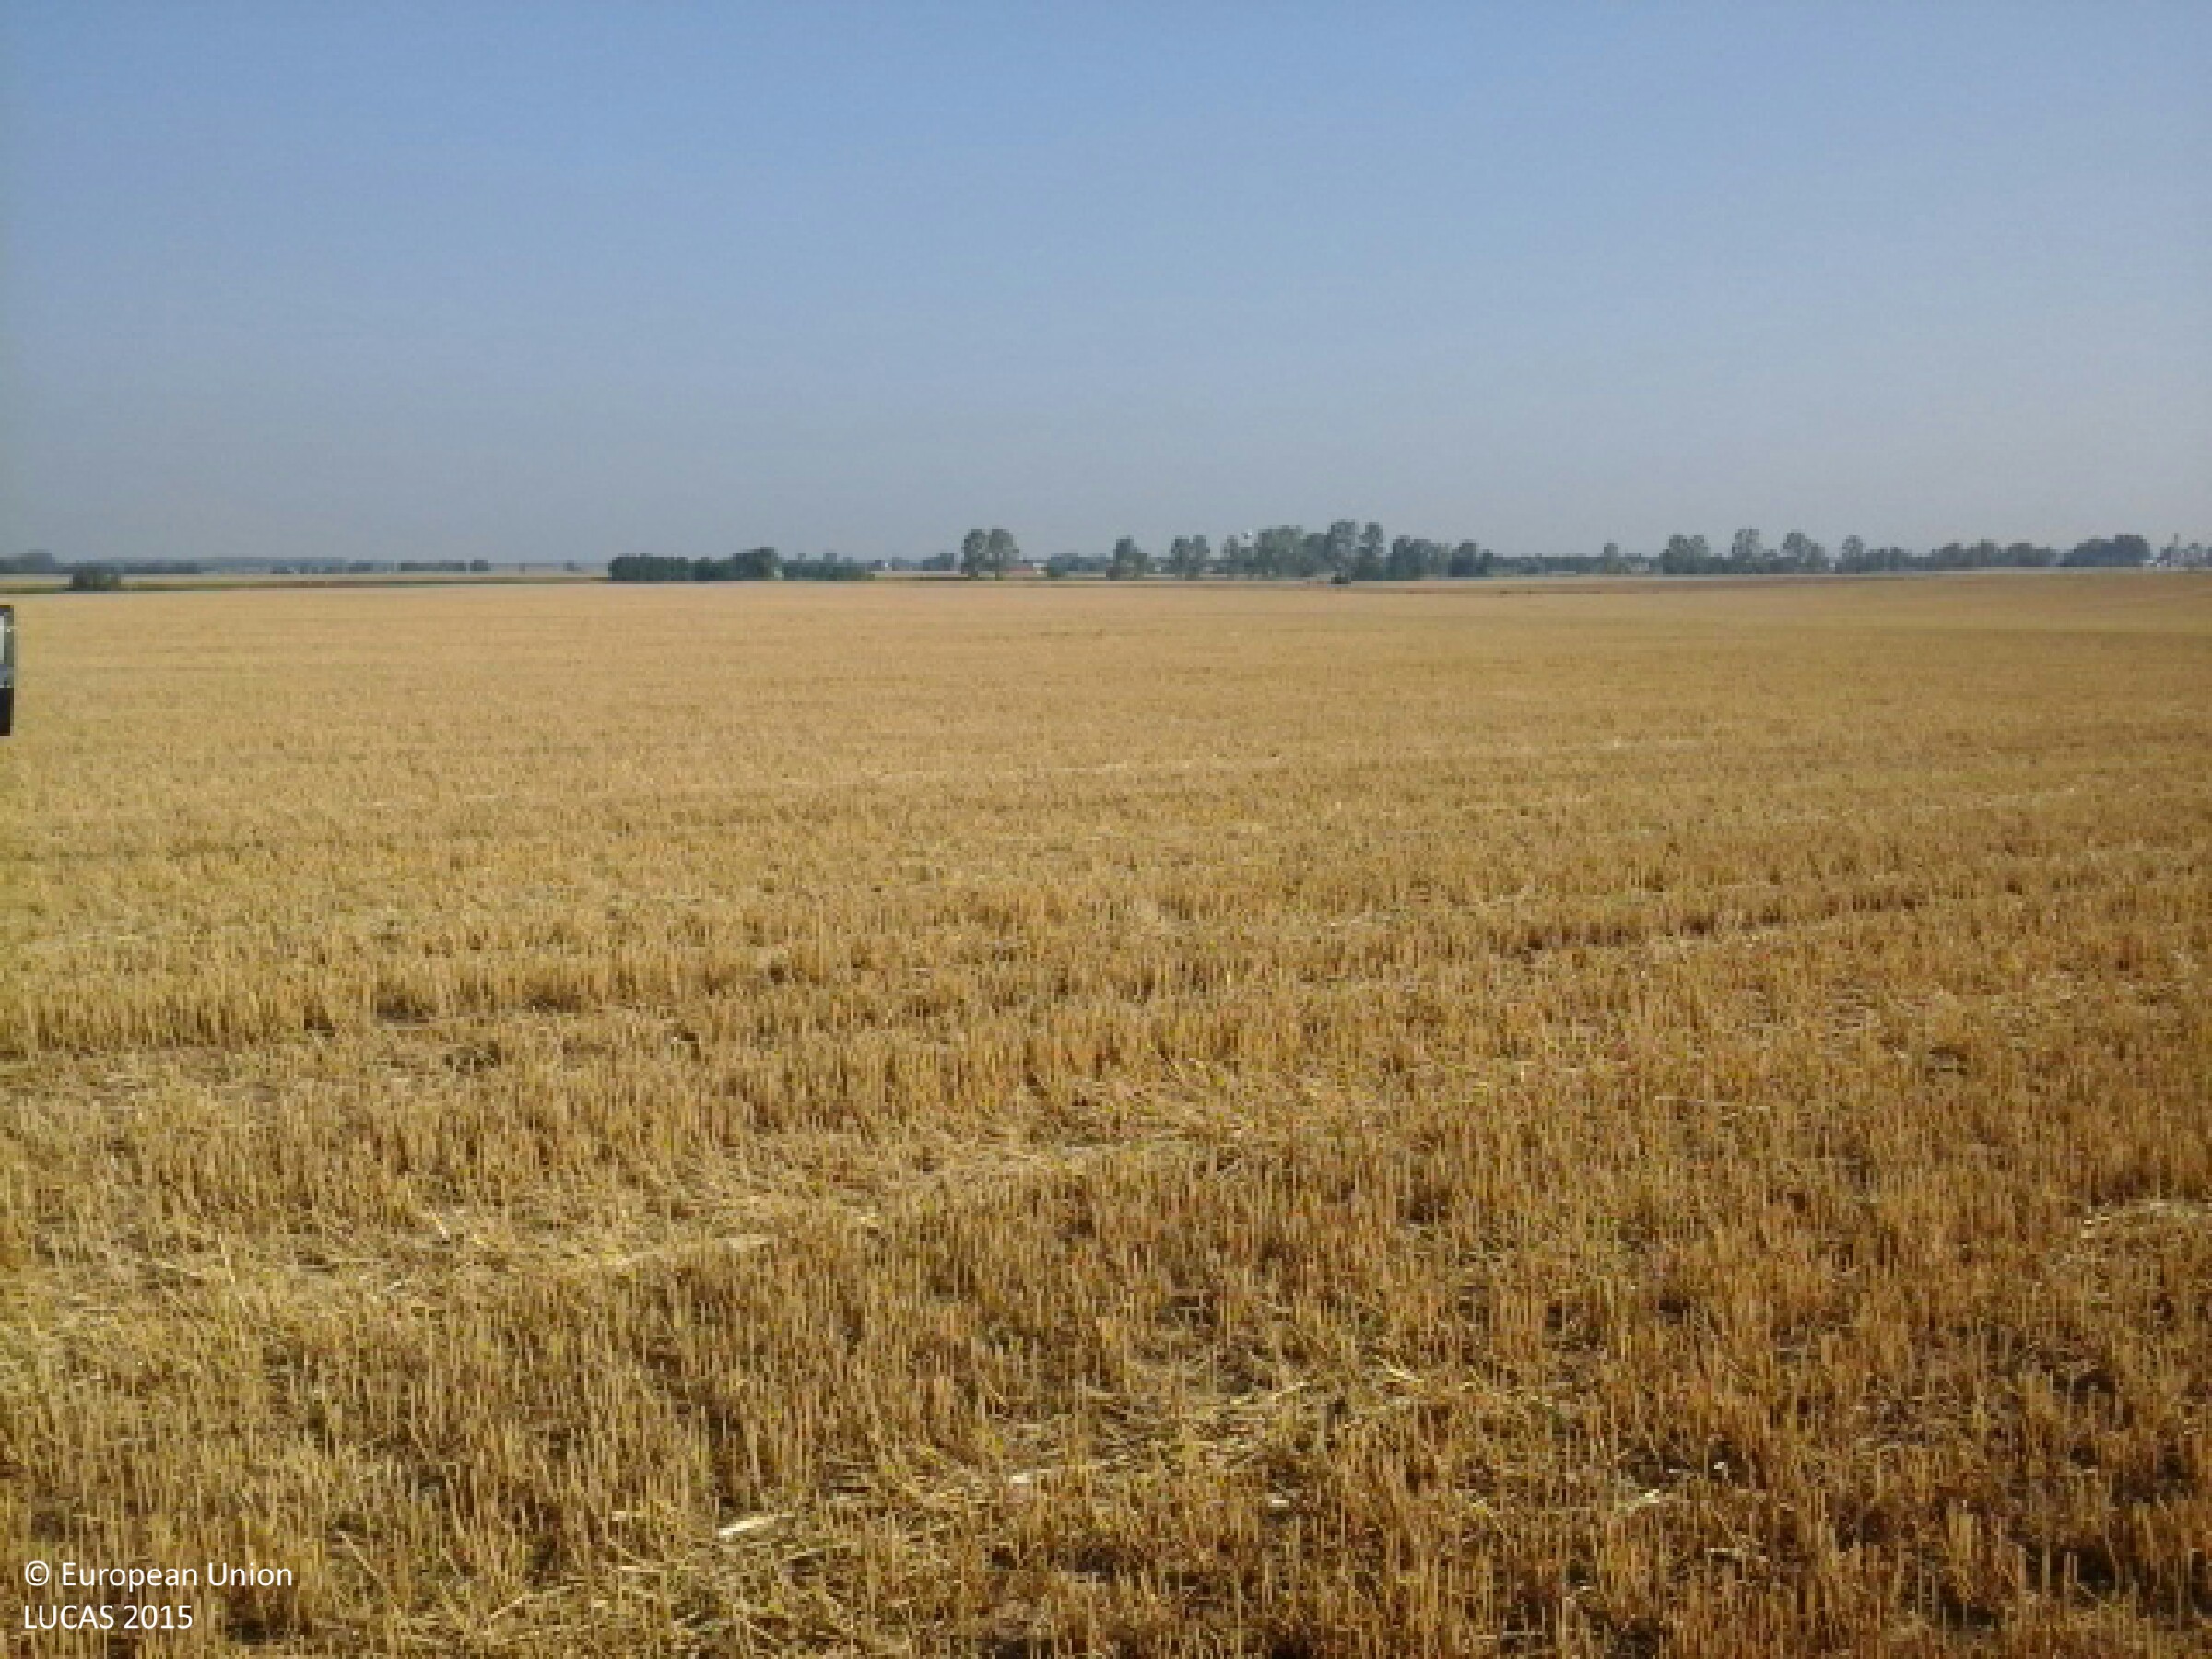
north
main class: Cropland
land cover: Common wheat
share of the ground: 10 - 25 %
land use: Agriculture (excluding fallow land and kitchen gardens)
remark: Harvested field
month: August
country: HU
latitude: 47.6782
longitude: 18.2581
